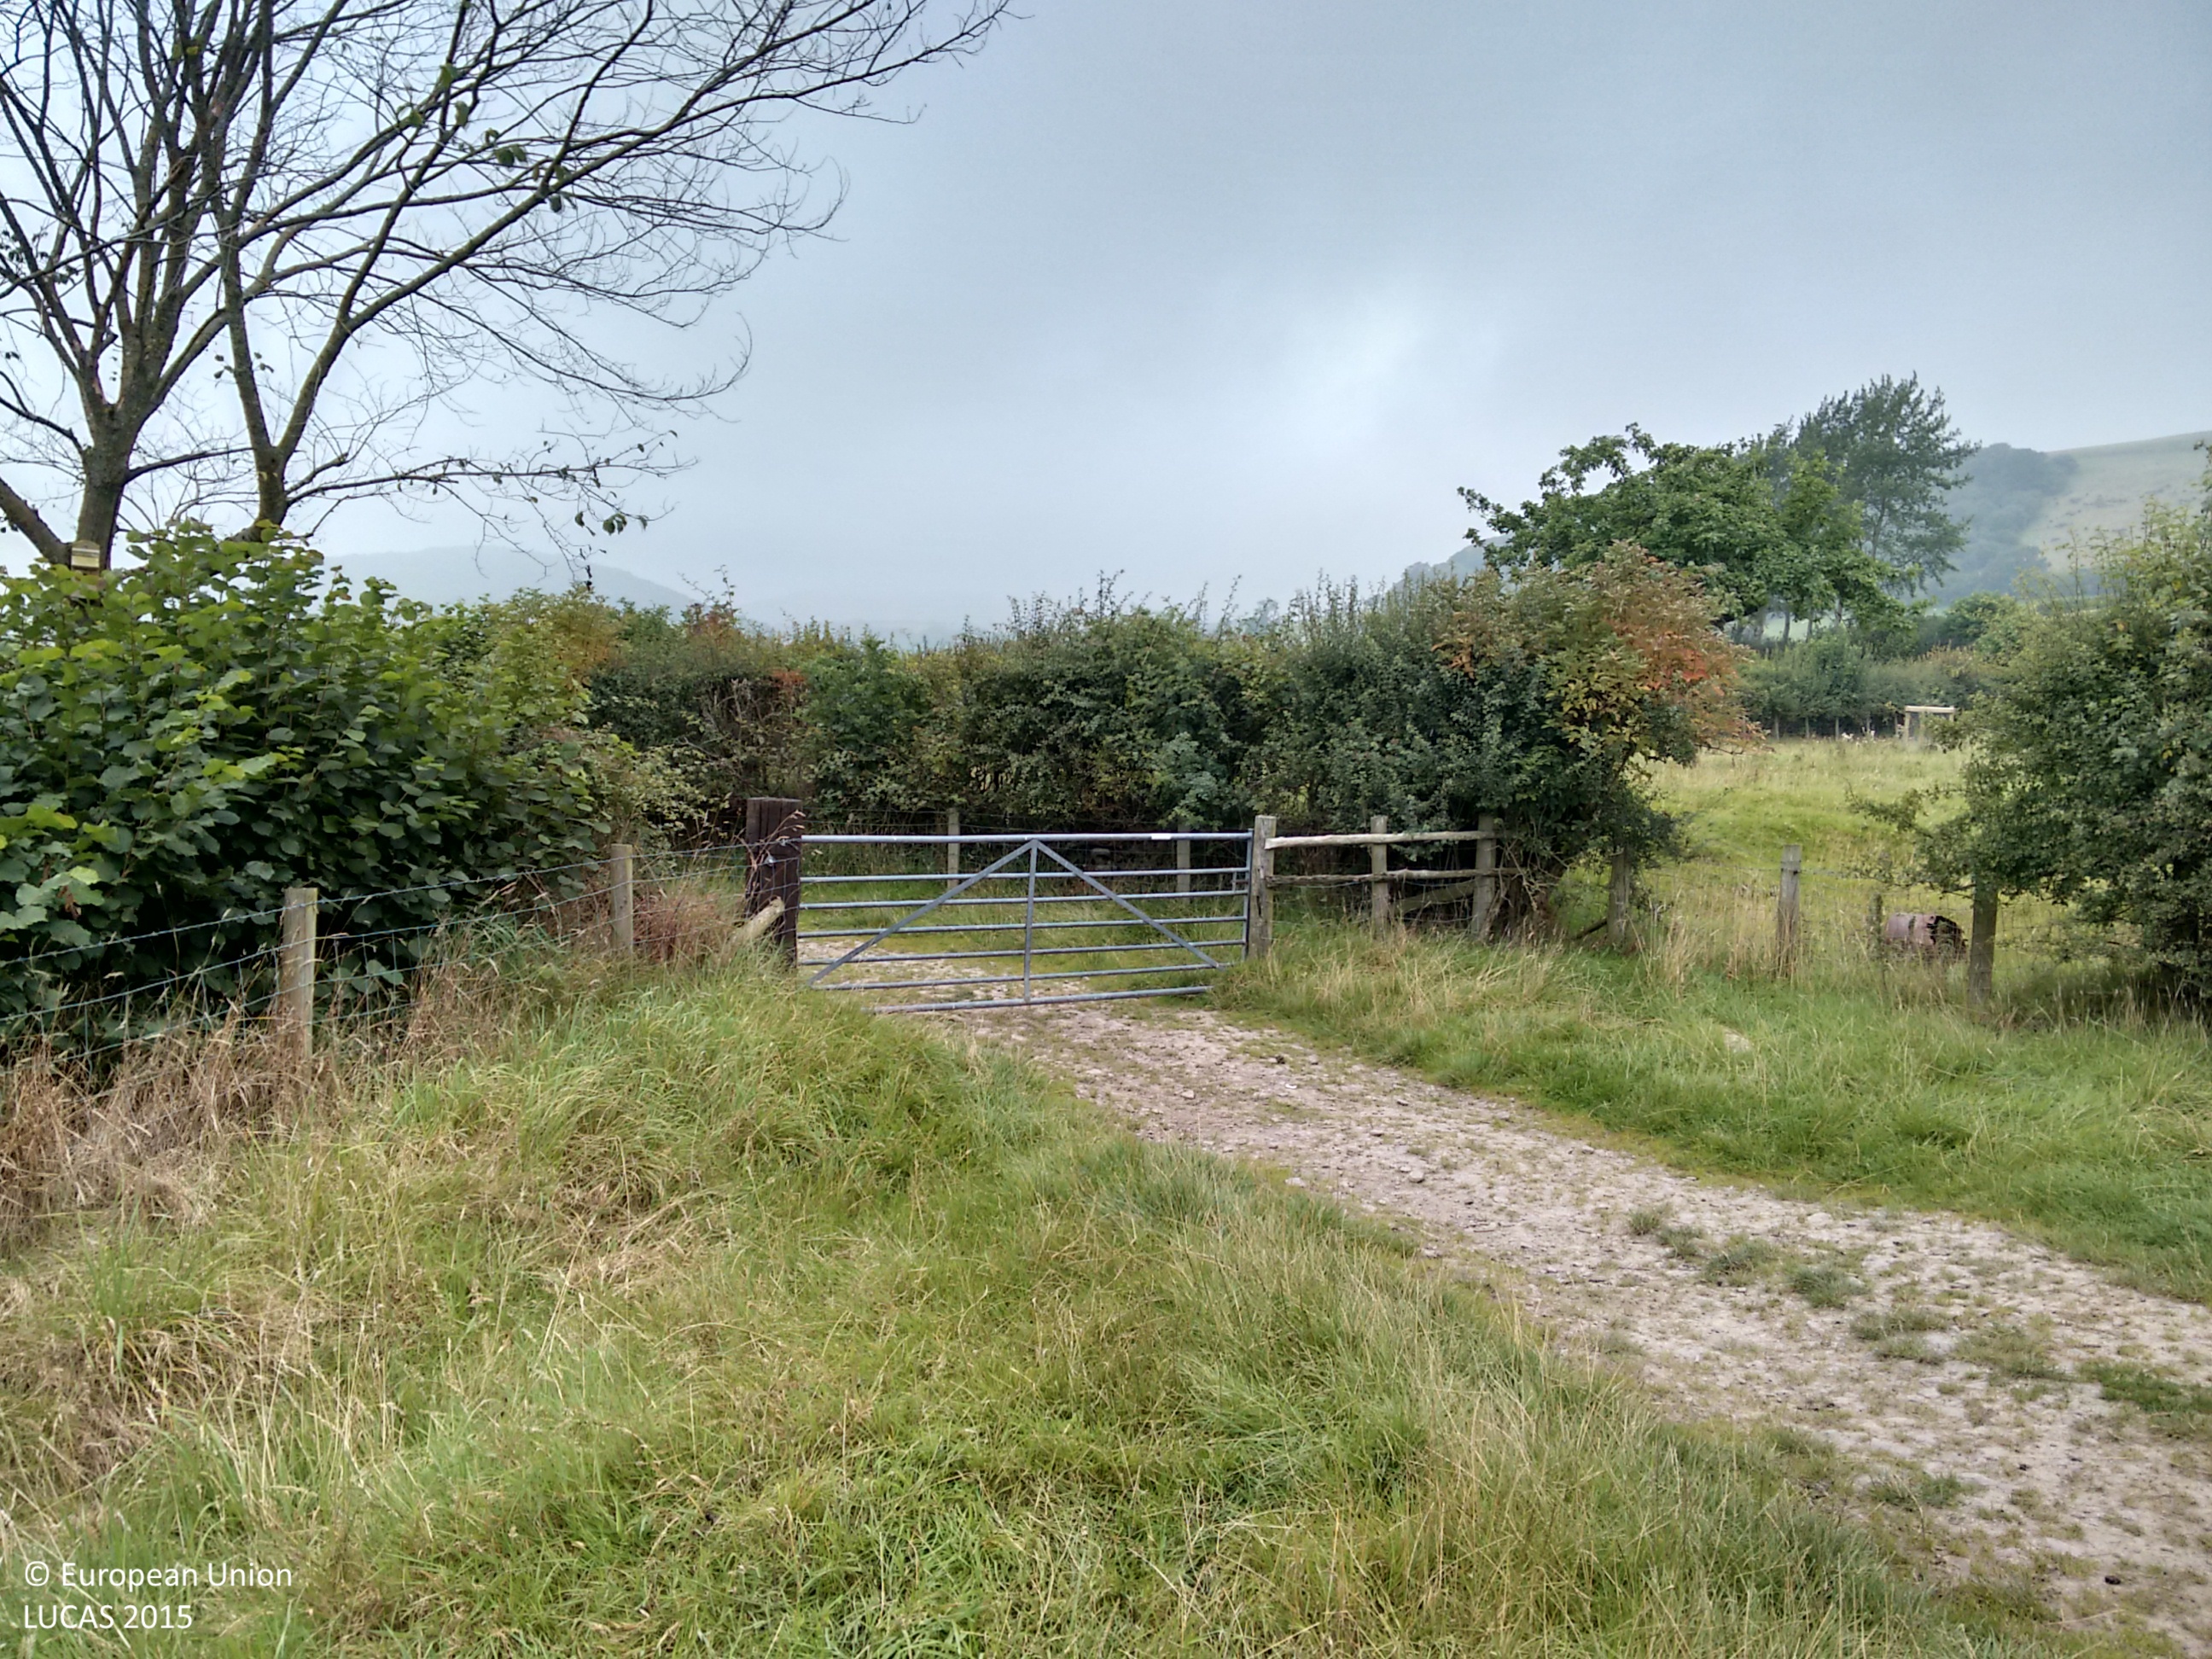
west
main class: Grassland
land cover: Grassland with sparse tree/shrub cover
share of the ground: > 75 %
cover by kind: herbaceous plants 95 %, coniferous forest trees 5 %
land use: Agriculture (excluding fallow land and kitchen gardens)
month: September
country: GB
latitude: 52.1062
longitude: -3.2344
